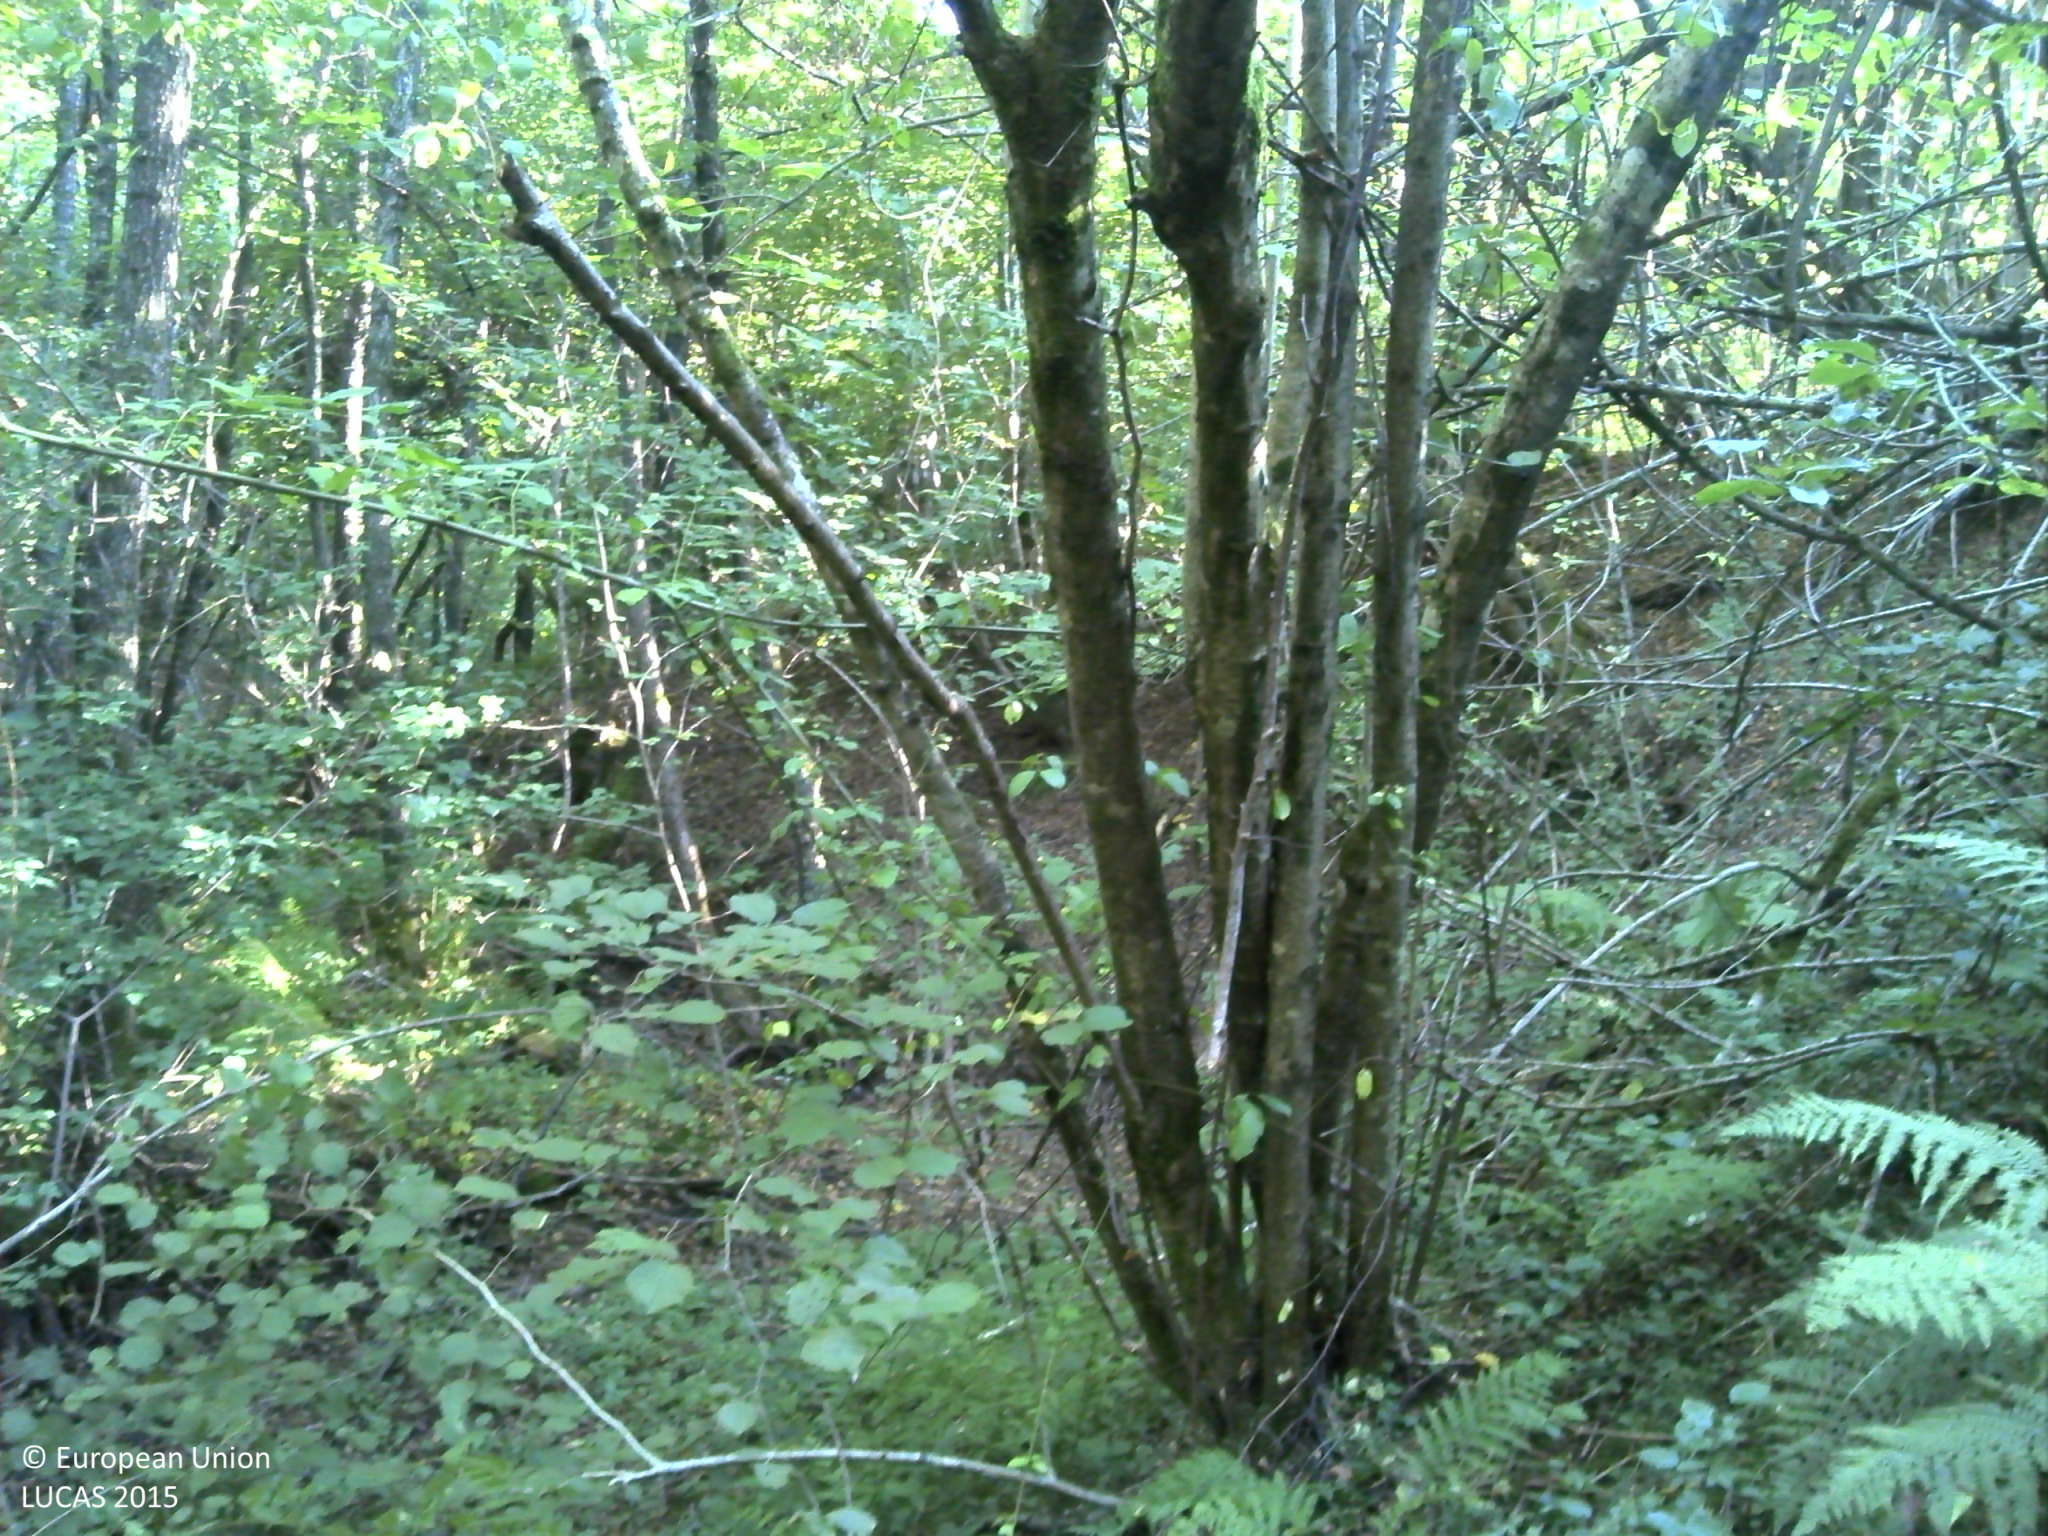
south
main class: Woodland
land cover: Broadleaved woodland
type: beech forest
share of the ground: > 75 %
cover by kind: broadleaved forest trees 100 %
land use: Forestry
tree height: > 5 m
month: August
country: HR
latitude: 45.1165
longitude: 16.3142
